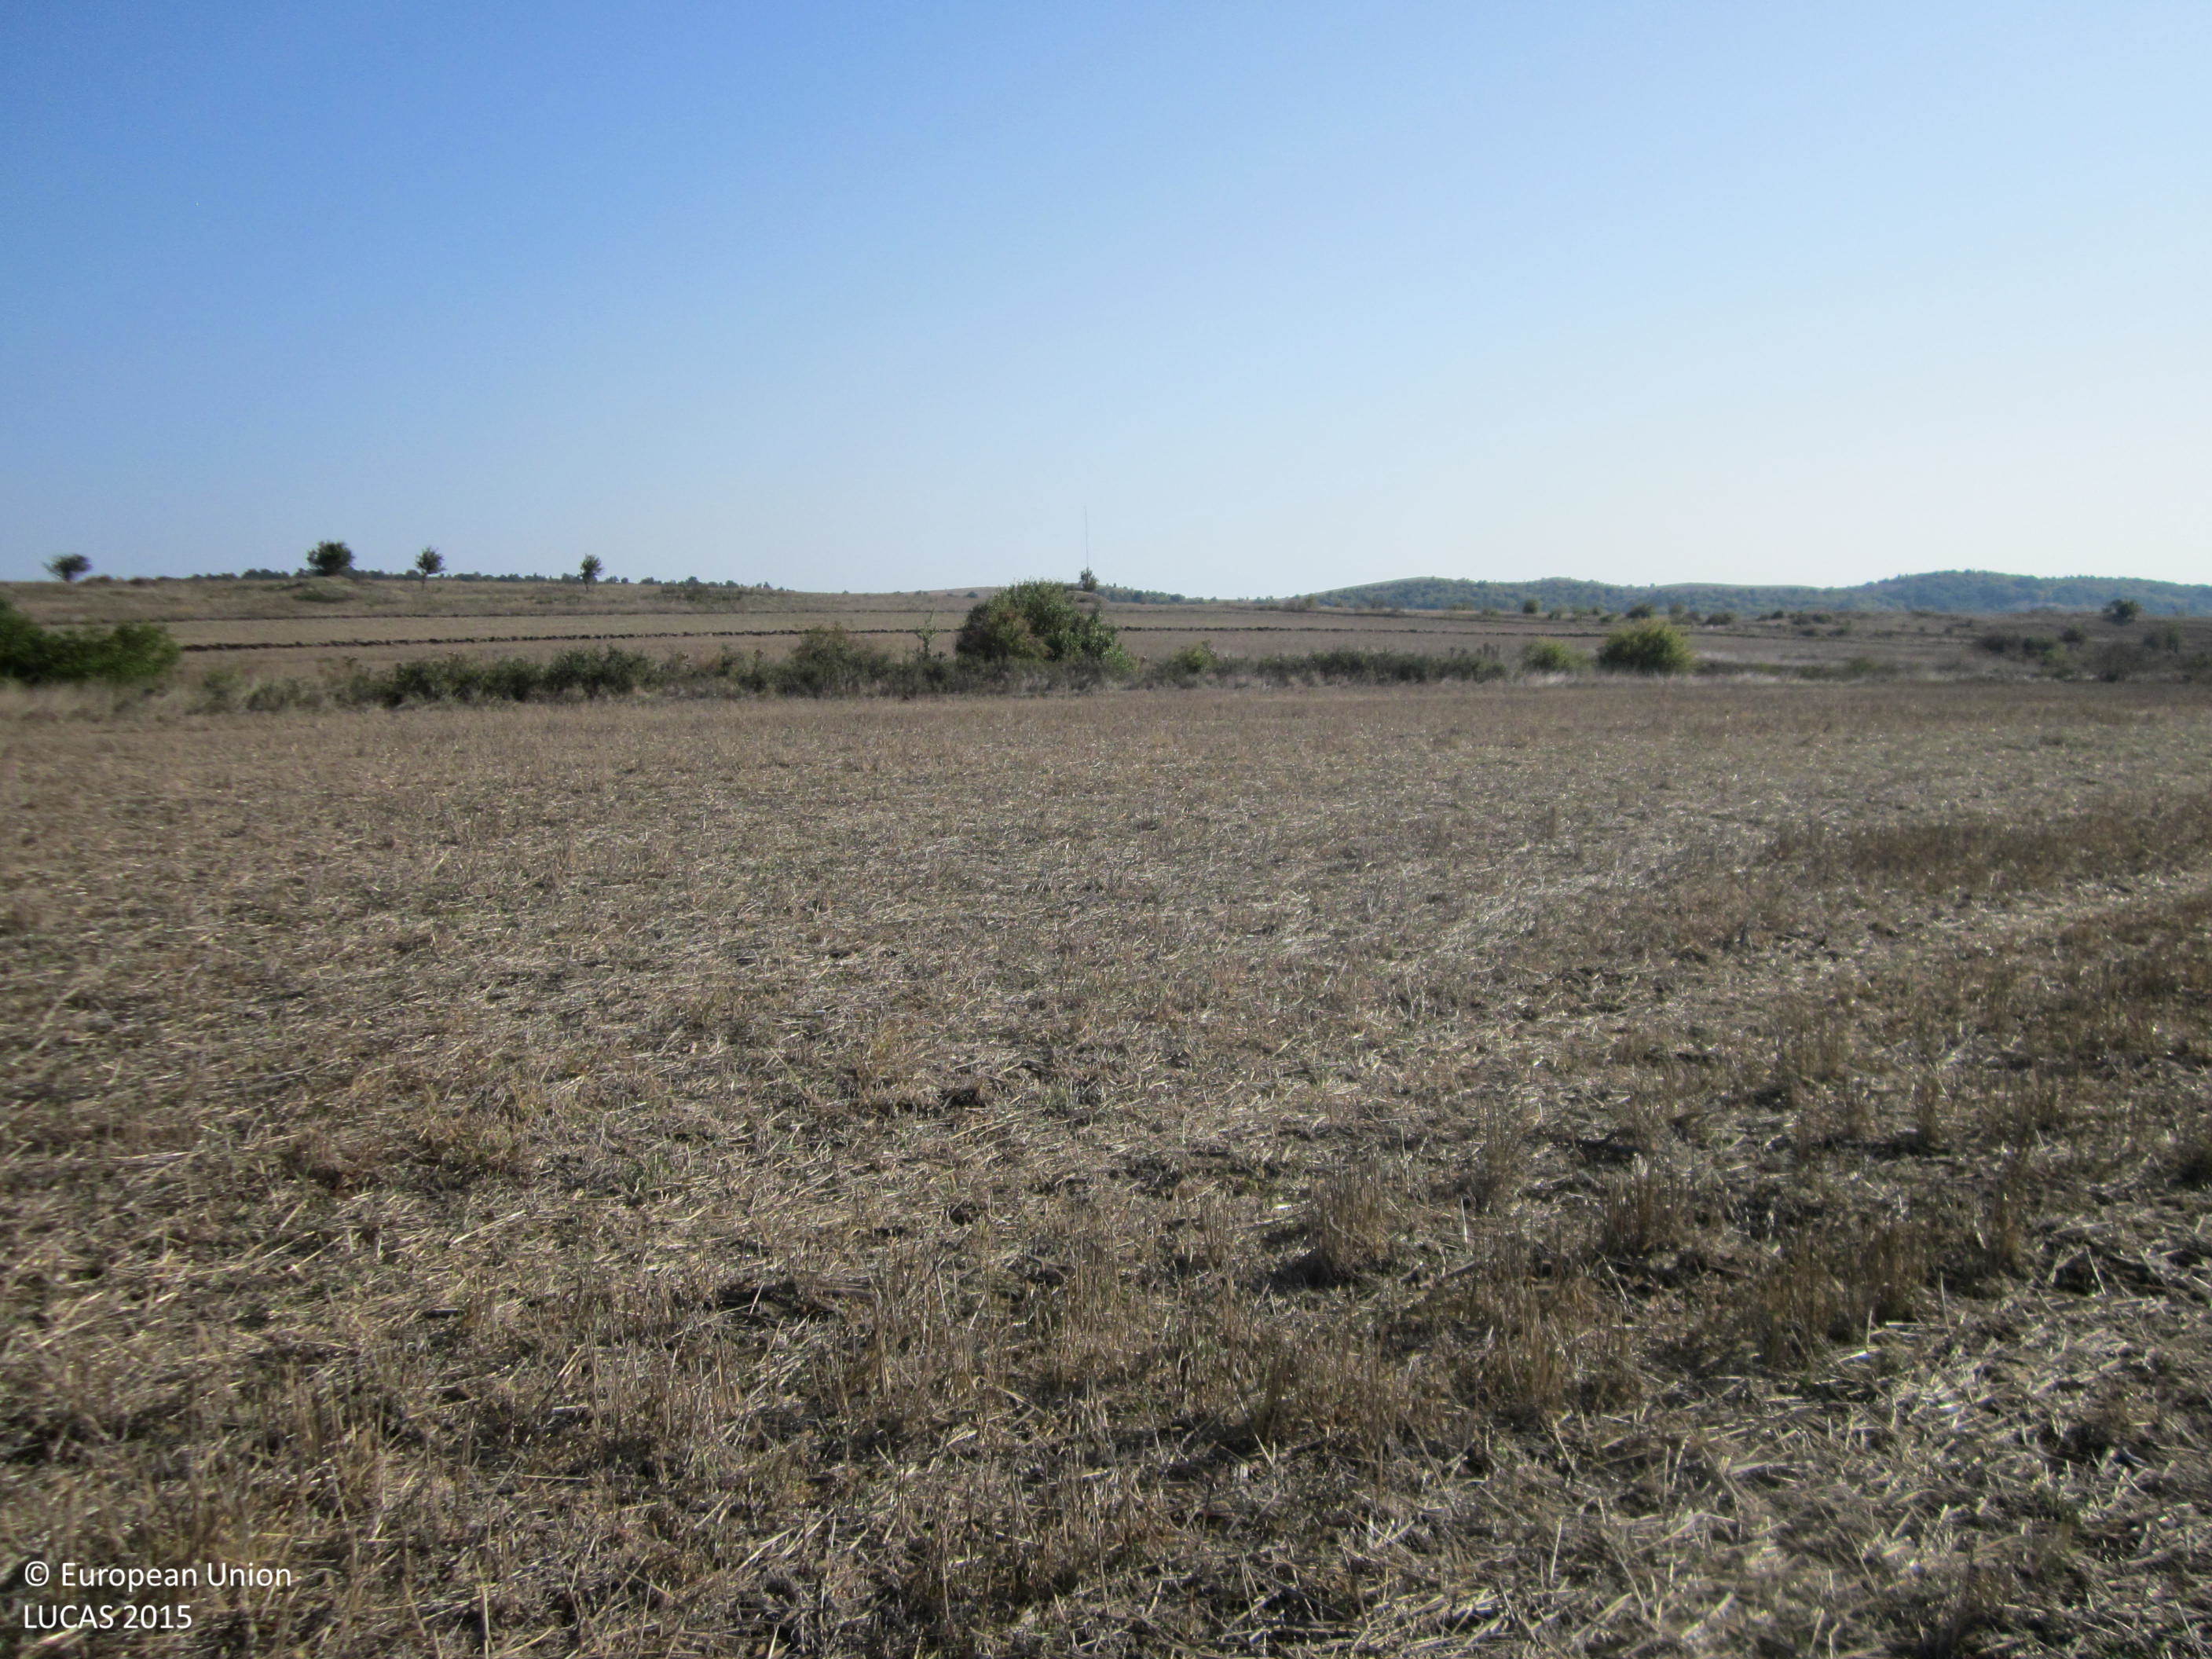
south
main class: Cropland
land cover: Common wheat
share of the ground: 10 - 25 %
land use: Agriculture (excluding fallow land and kitchen gardens)
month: September
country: BG
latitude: 42.6847
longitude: 27.3866
